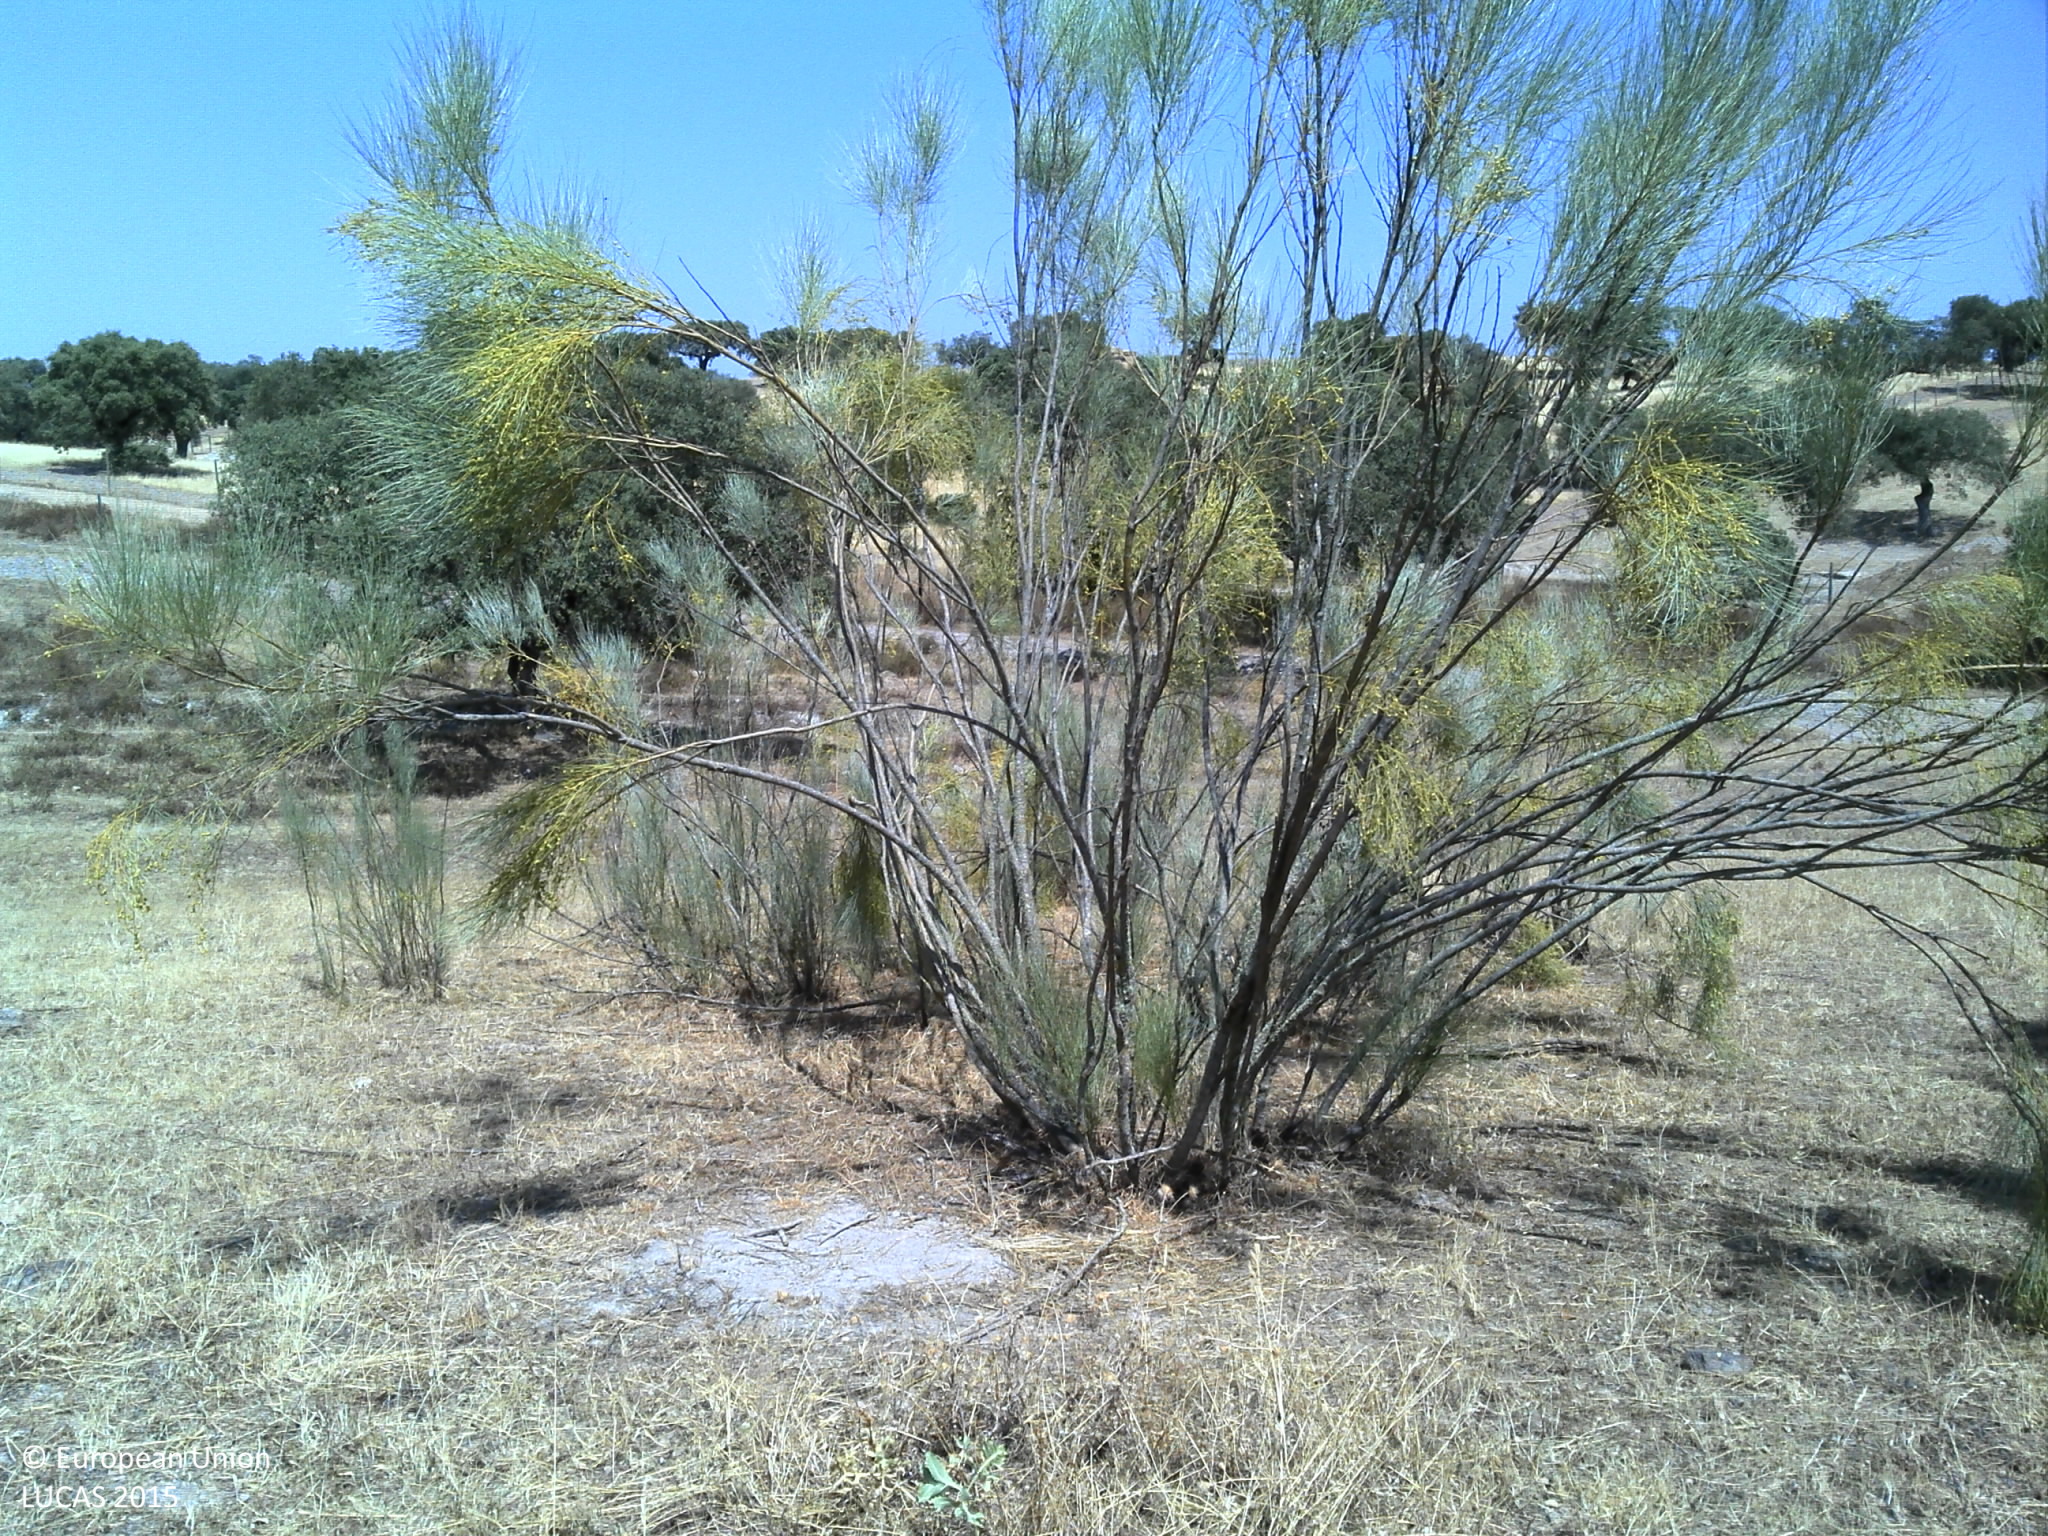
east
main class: Woodland
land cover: Broadleaved woodland
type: broadleaved evergreen forest
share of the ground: 10 - 25 %
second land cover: Grassland without tree/shrub cover
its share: 10 - 25 %
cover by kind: unconsolidated bare surface 55 %, broadleaved forest trees 25 %, herbaceous plants 20 %
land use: Forestry
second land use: Agriculture (excluding fallow land and kitchen gardens)
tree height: > 5 m
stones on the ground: < 10 %
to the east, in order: Broadleaved woodland; Grassland without tree/shrub cover; Broadleaved woodland; Rivers and streams; Broadleaved woodland; Tracks; Grass margins; Fences; Broadleaved woodland; Tracks; Grass margins; Fences; Broadleaved woodland; Fences; Grassland without tree/shrub cover; Rivers and streams; Broadleaved woodland; Grassland without tree/shrub cover; Fences; Grassland without tree/shrub cover; Artificial constructions in urban areas
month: June
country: PT
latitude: 38.2187
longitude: -7.3004
